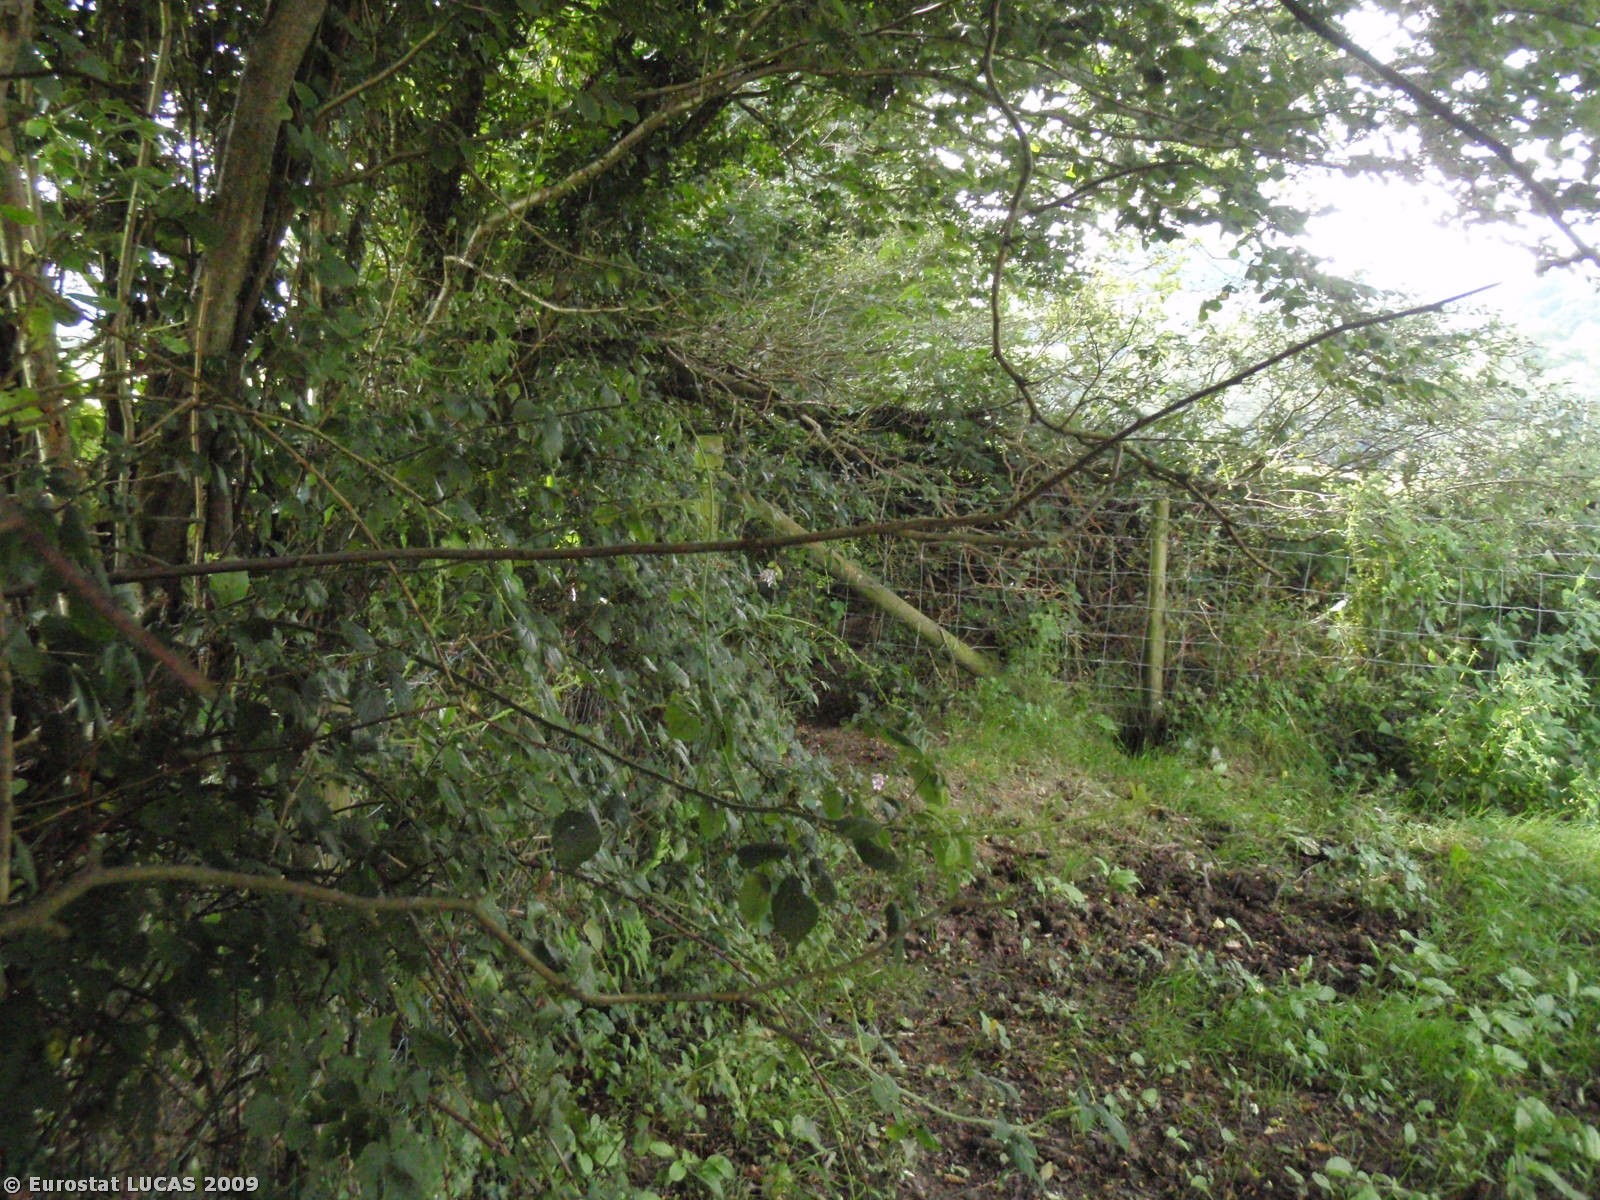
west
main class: Woodland
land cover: Broadleaved woodland
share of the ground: > 75 %
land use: Agriculture (excluding fallow land and kitchen gardens)
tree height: > 5 m
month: August
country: GB
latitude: 50.8545
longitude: -2.6979
